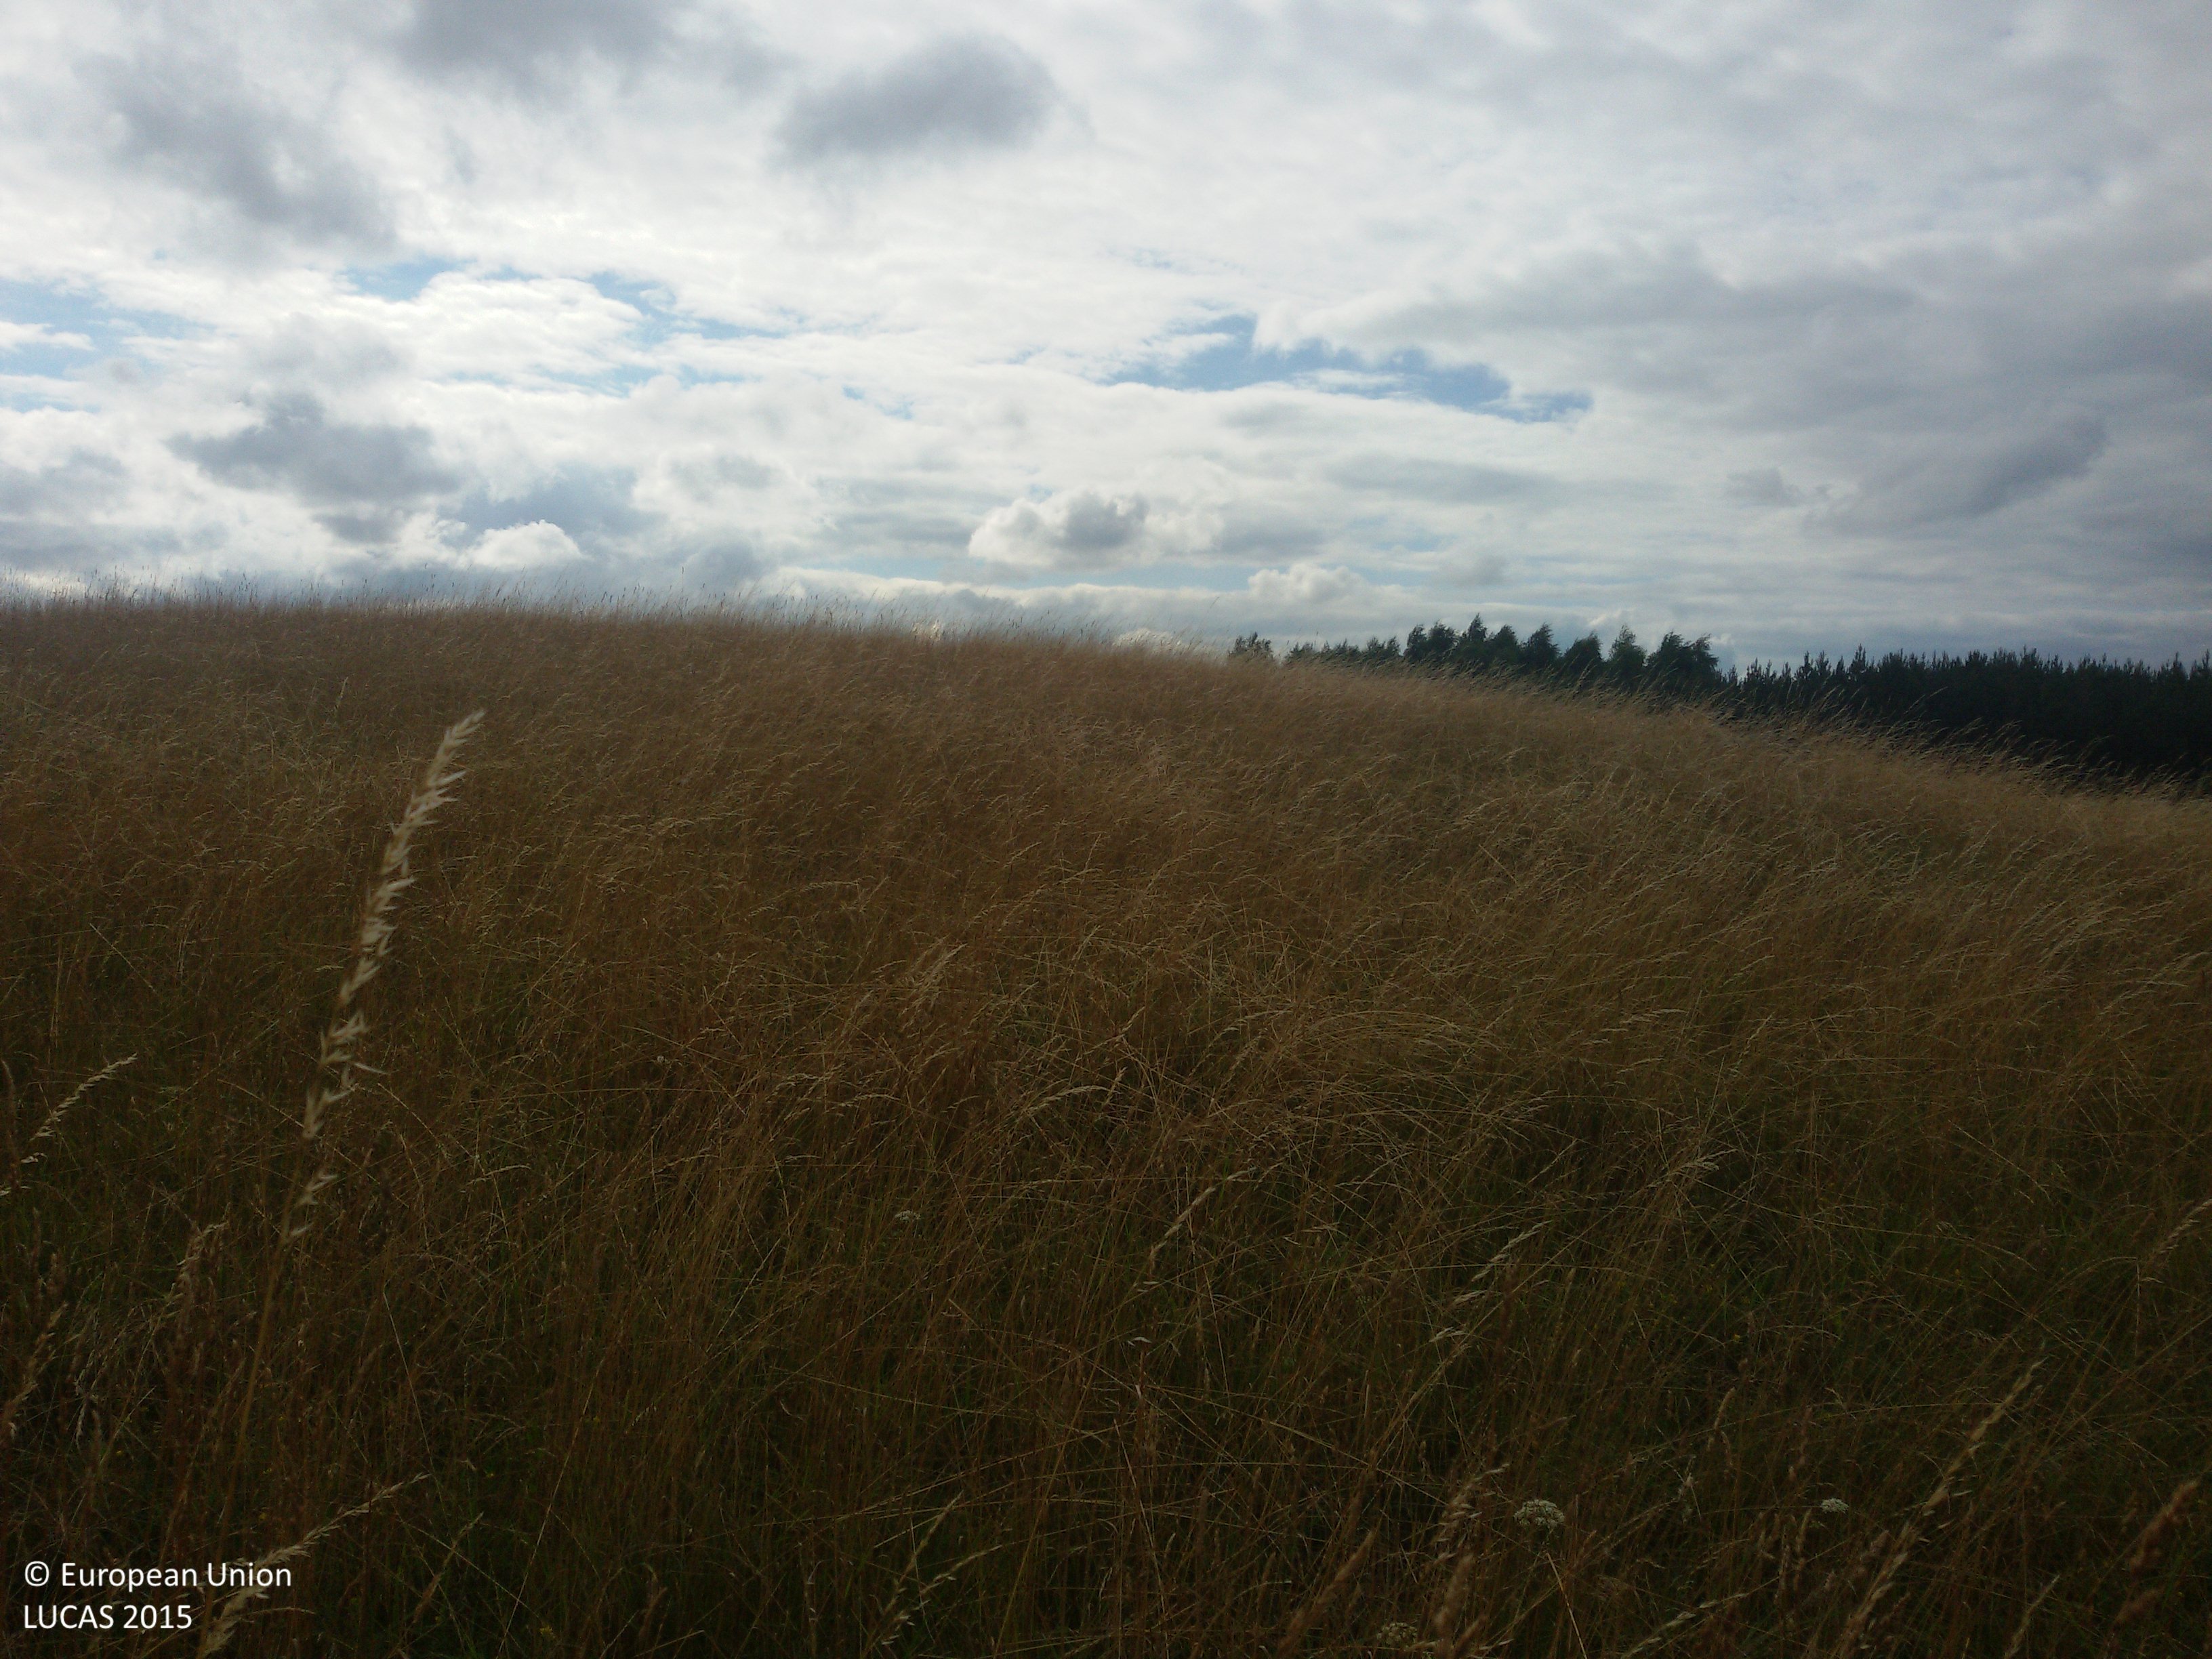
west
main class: Cropland
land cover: Triticale
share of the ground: > 75 %
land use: Agriculture (excluding fallow land and kitchen gardens)
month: July
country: PL
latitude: 53.6379
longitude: 23.5607
